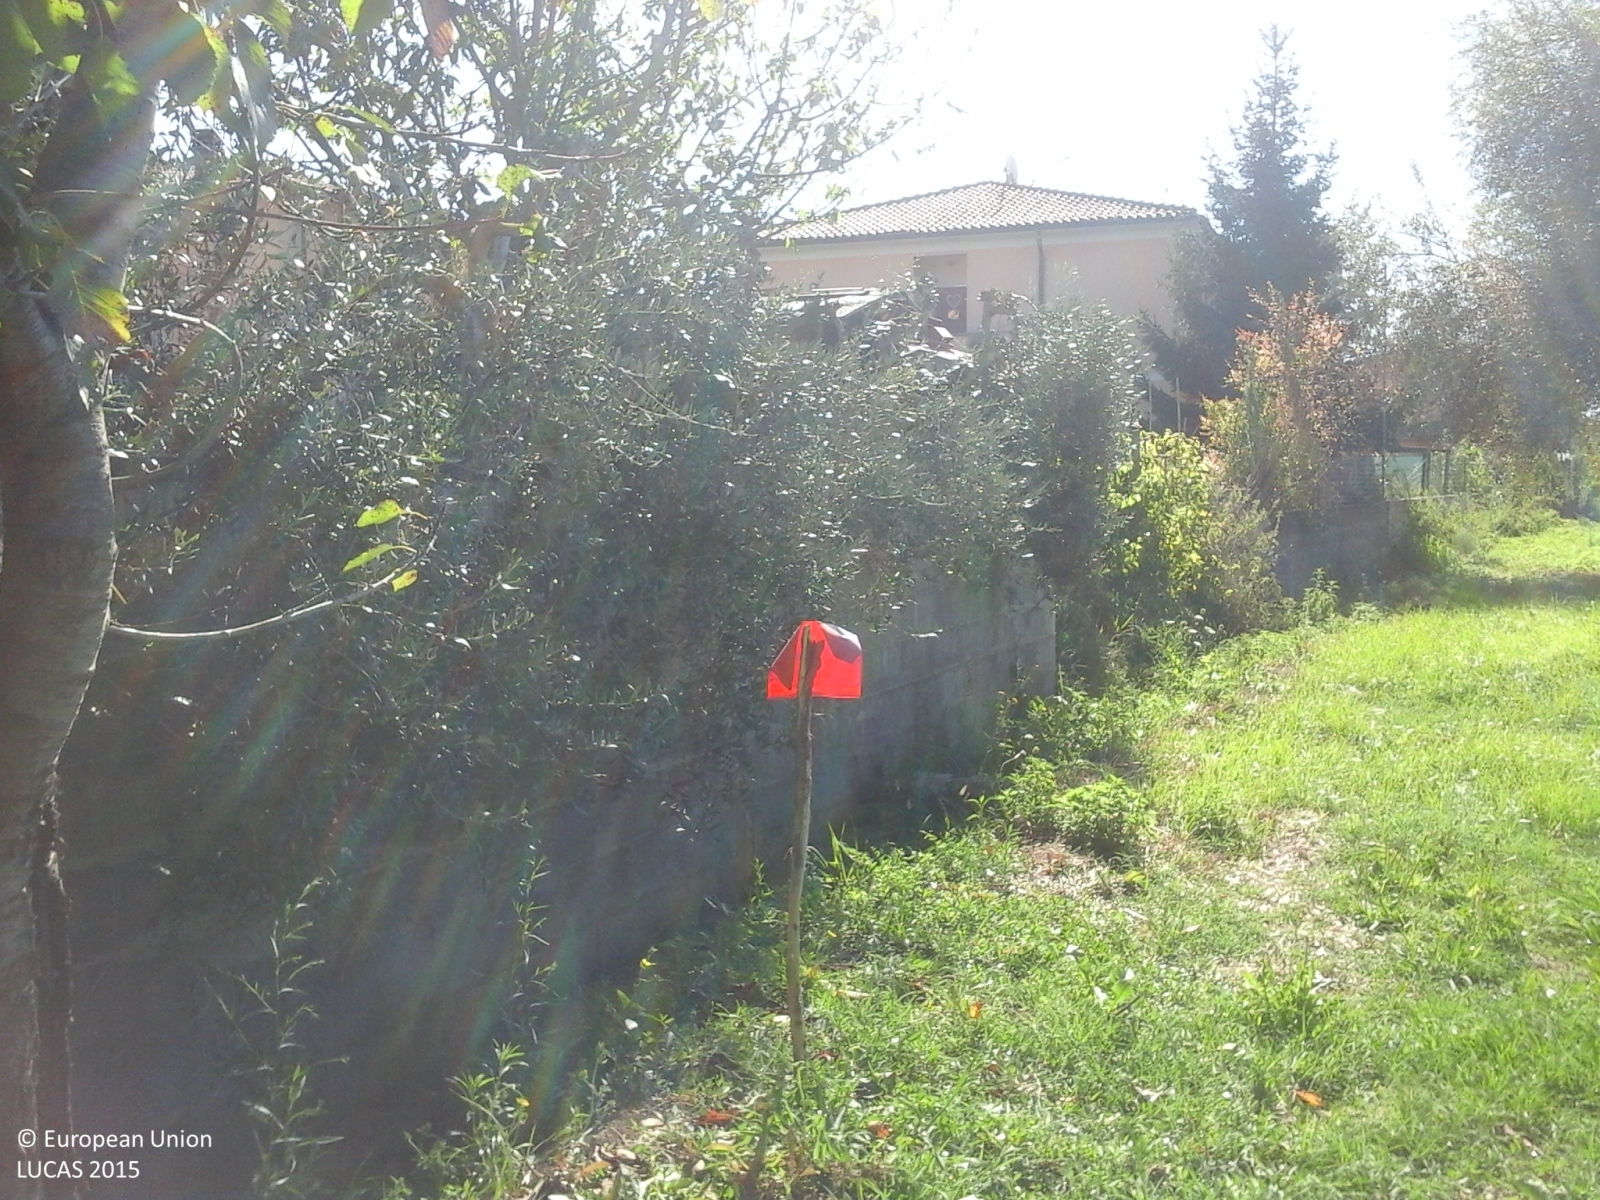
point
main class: Grassland
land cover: Grassland without tree/shrub cover
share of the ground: > 75 %
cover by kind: herbaceous plants 100 %
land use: Agriculture (excluding fallow land and kitchen gardens)
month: August
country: IT
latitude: 43.7726
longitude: 10.3593
